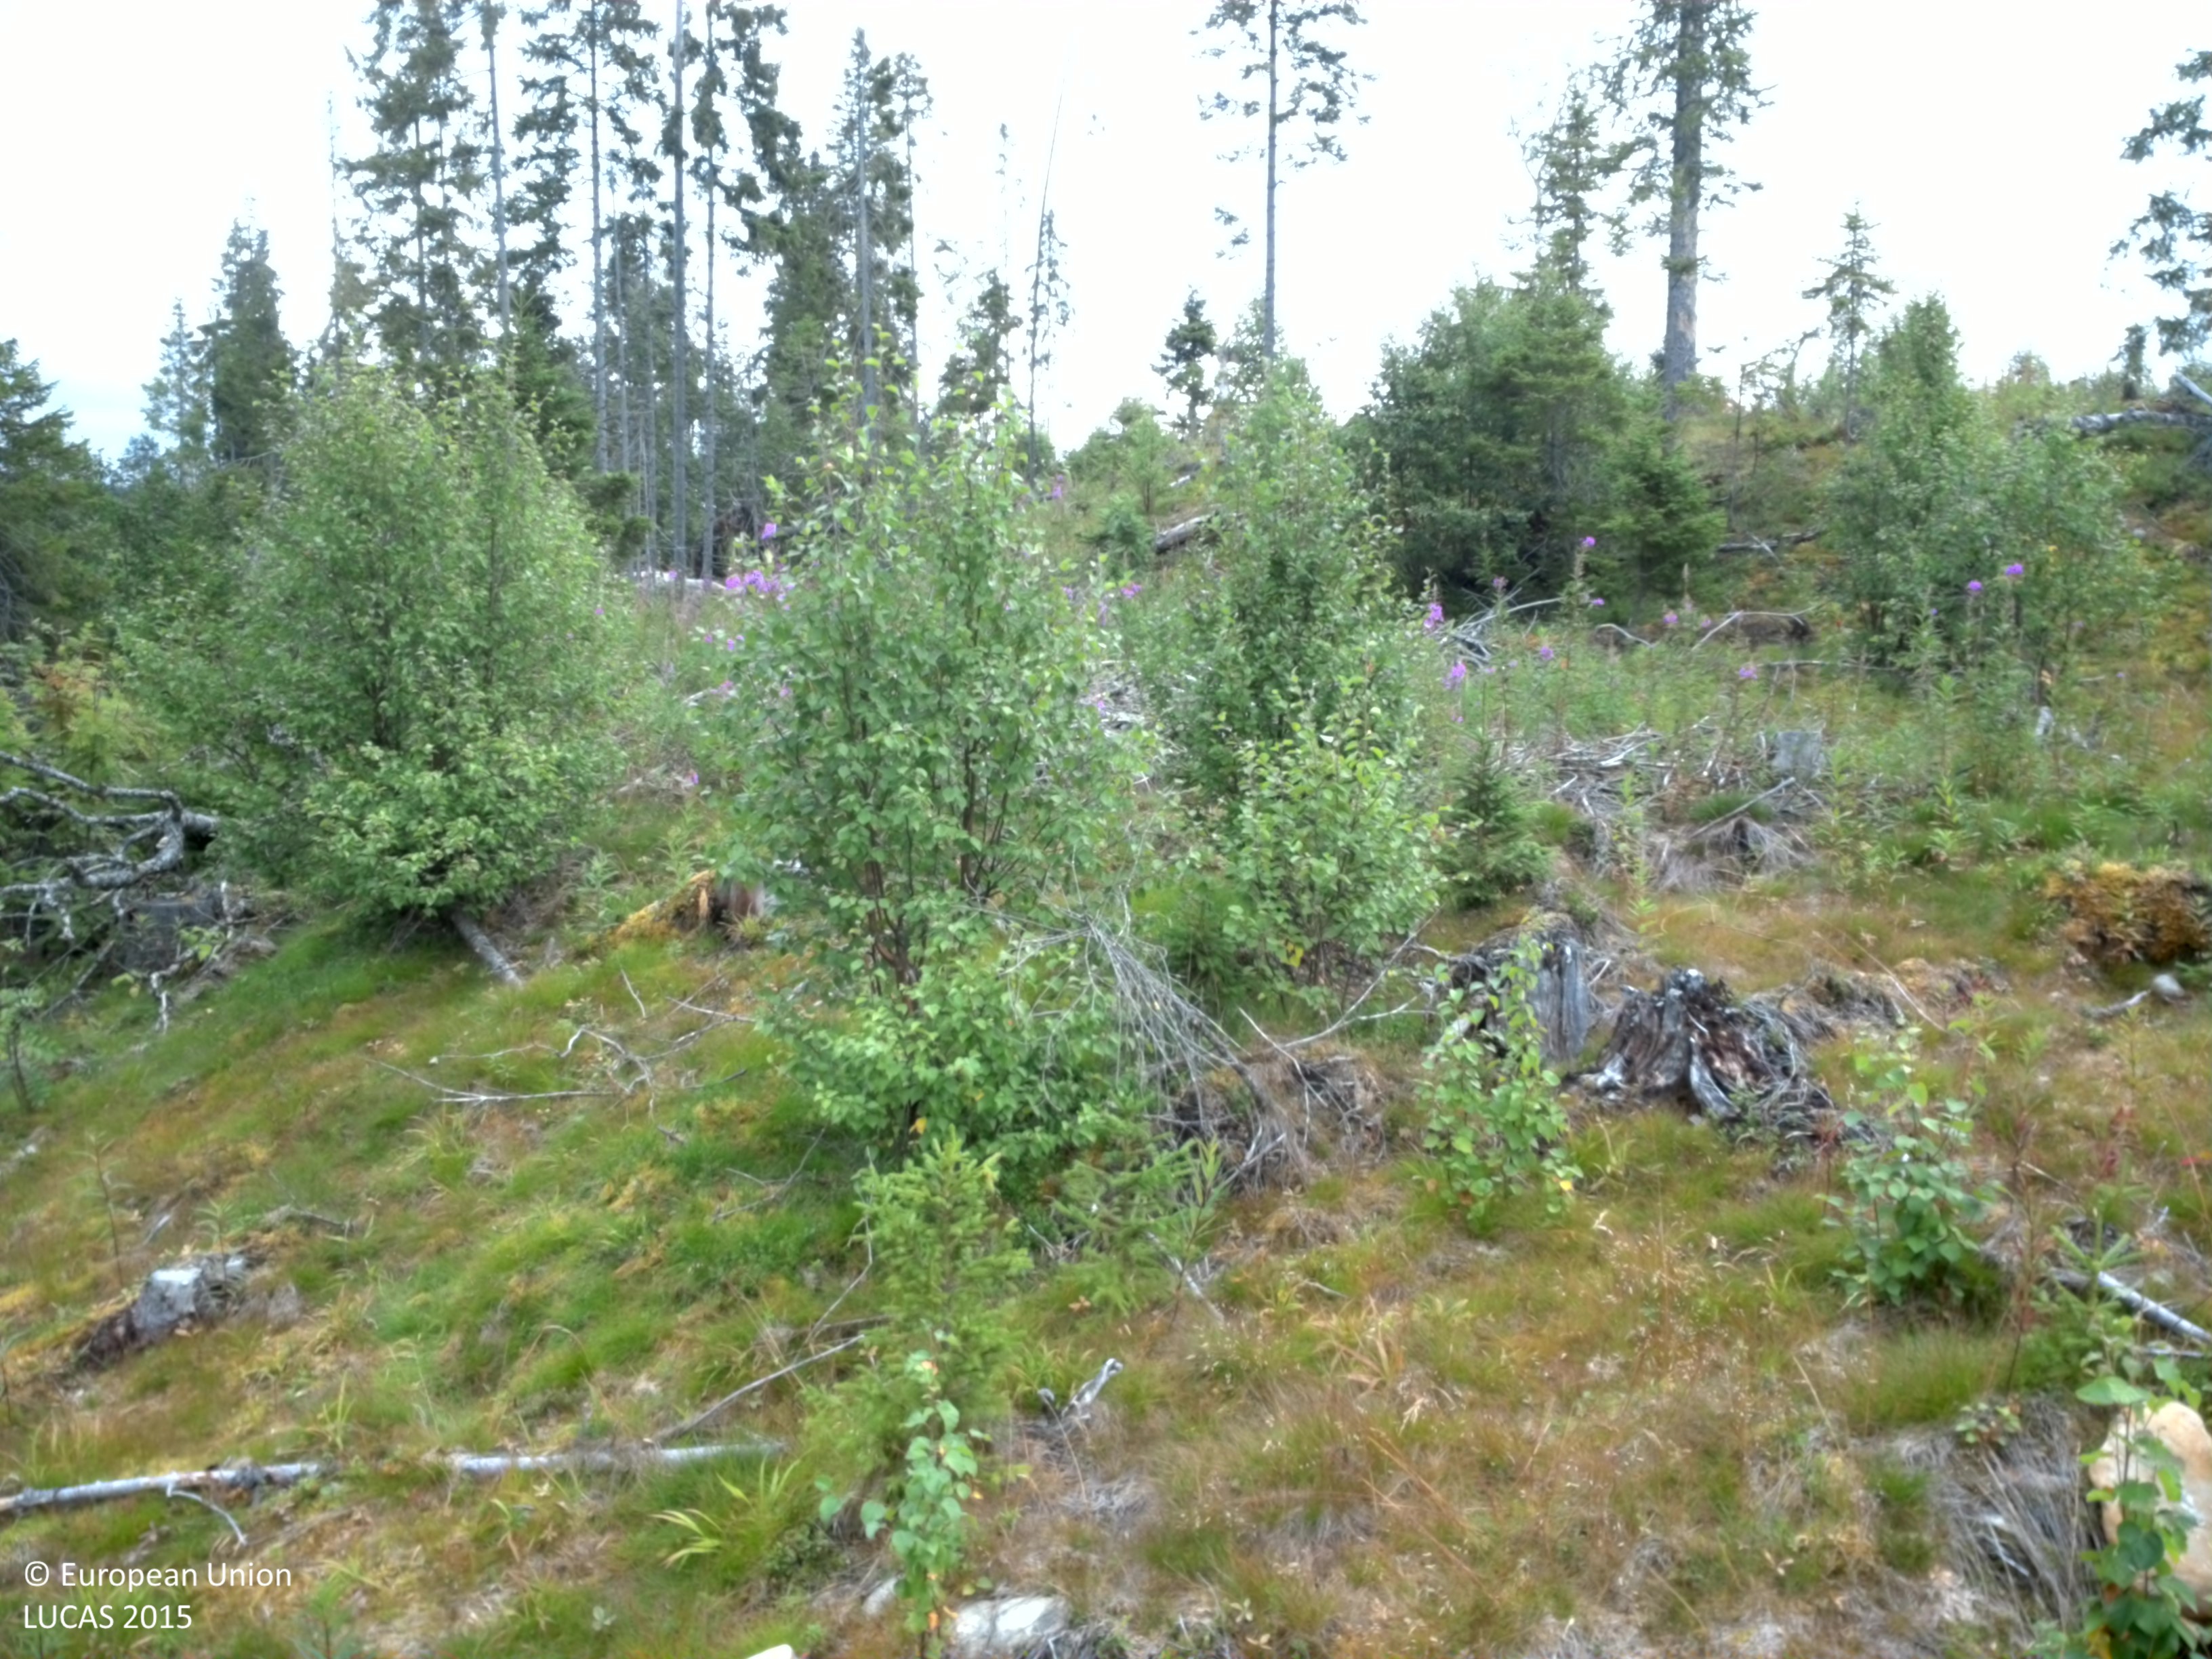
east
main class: Grassland
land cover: Grassland with sparse tree/shrub cover
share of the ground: > 75 %
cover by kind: herbaceous plants 80 %, broadleaved forest trees 5 %, shrubs 5 %, lichens and mosses 5 %
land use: Forestry
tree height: < 5 m
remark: Clear cut
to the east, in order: Grassland with sparse tree/shrub cover; Spruce dominated mixed woodland; Broadleaved woodland; Shrubland with sparse tree cover; Grassland with sparse tree/shrub cover; Shrubland with sparse tree cover; Grassland with sparse tree/shrub cover
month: August
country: SE
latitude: 64.7869
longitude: 16.5933
